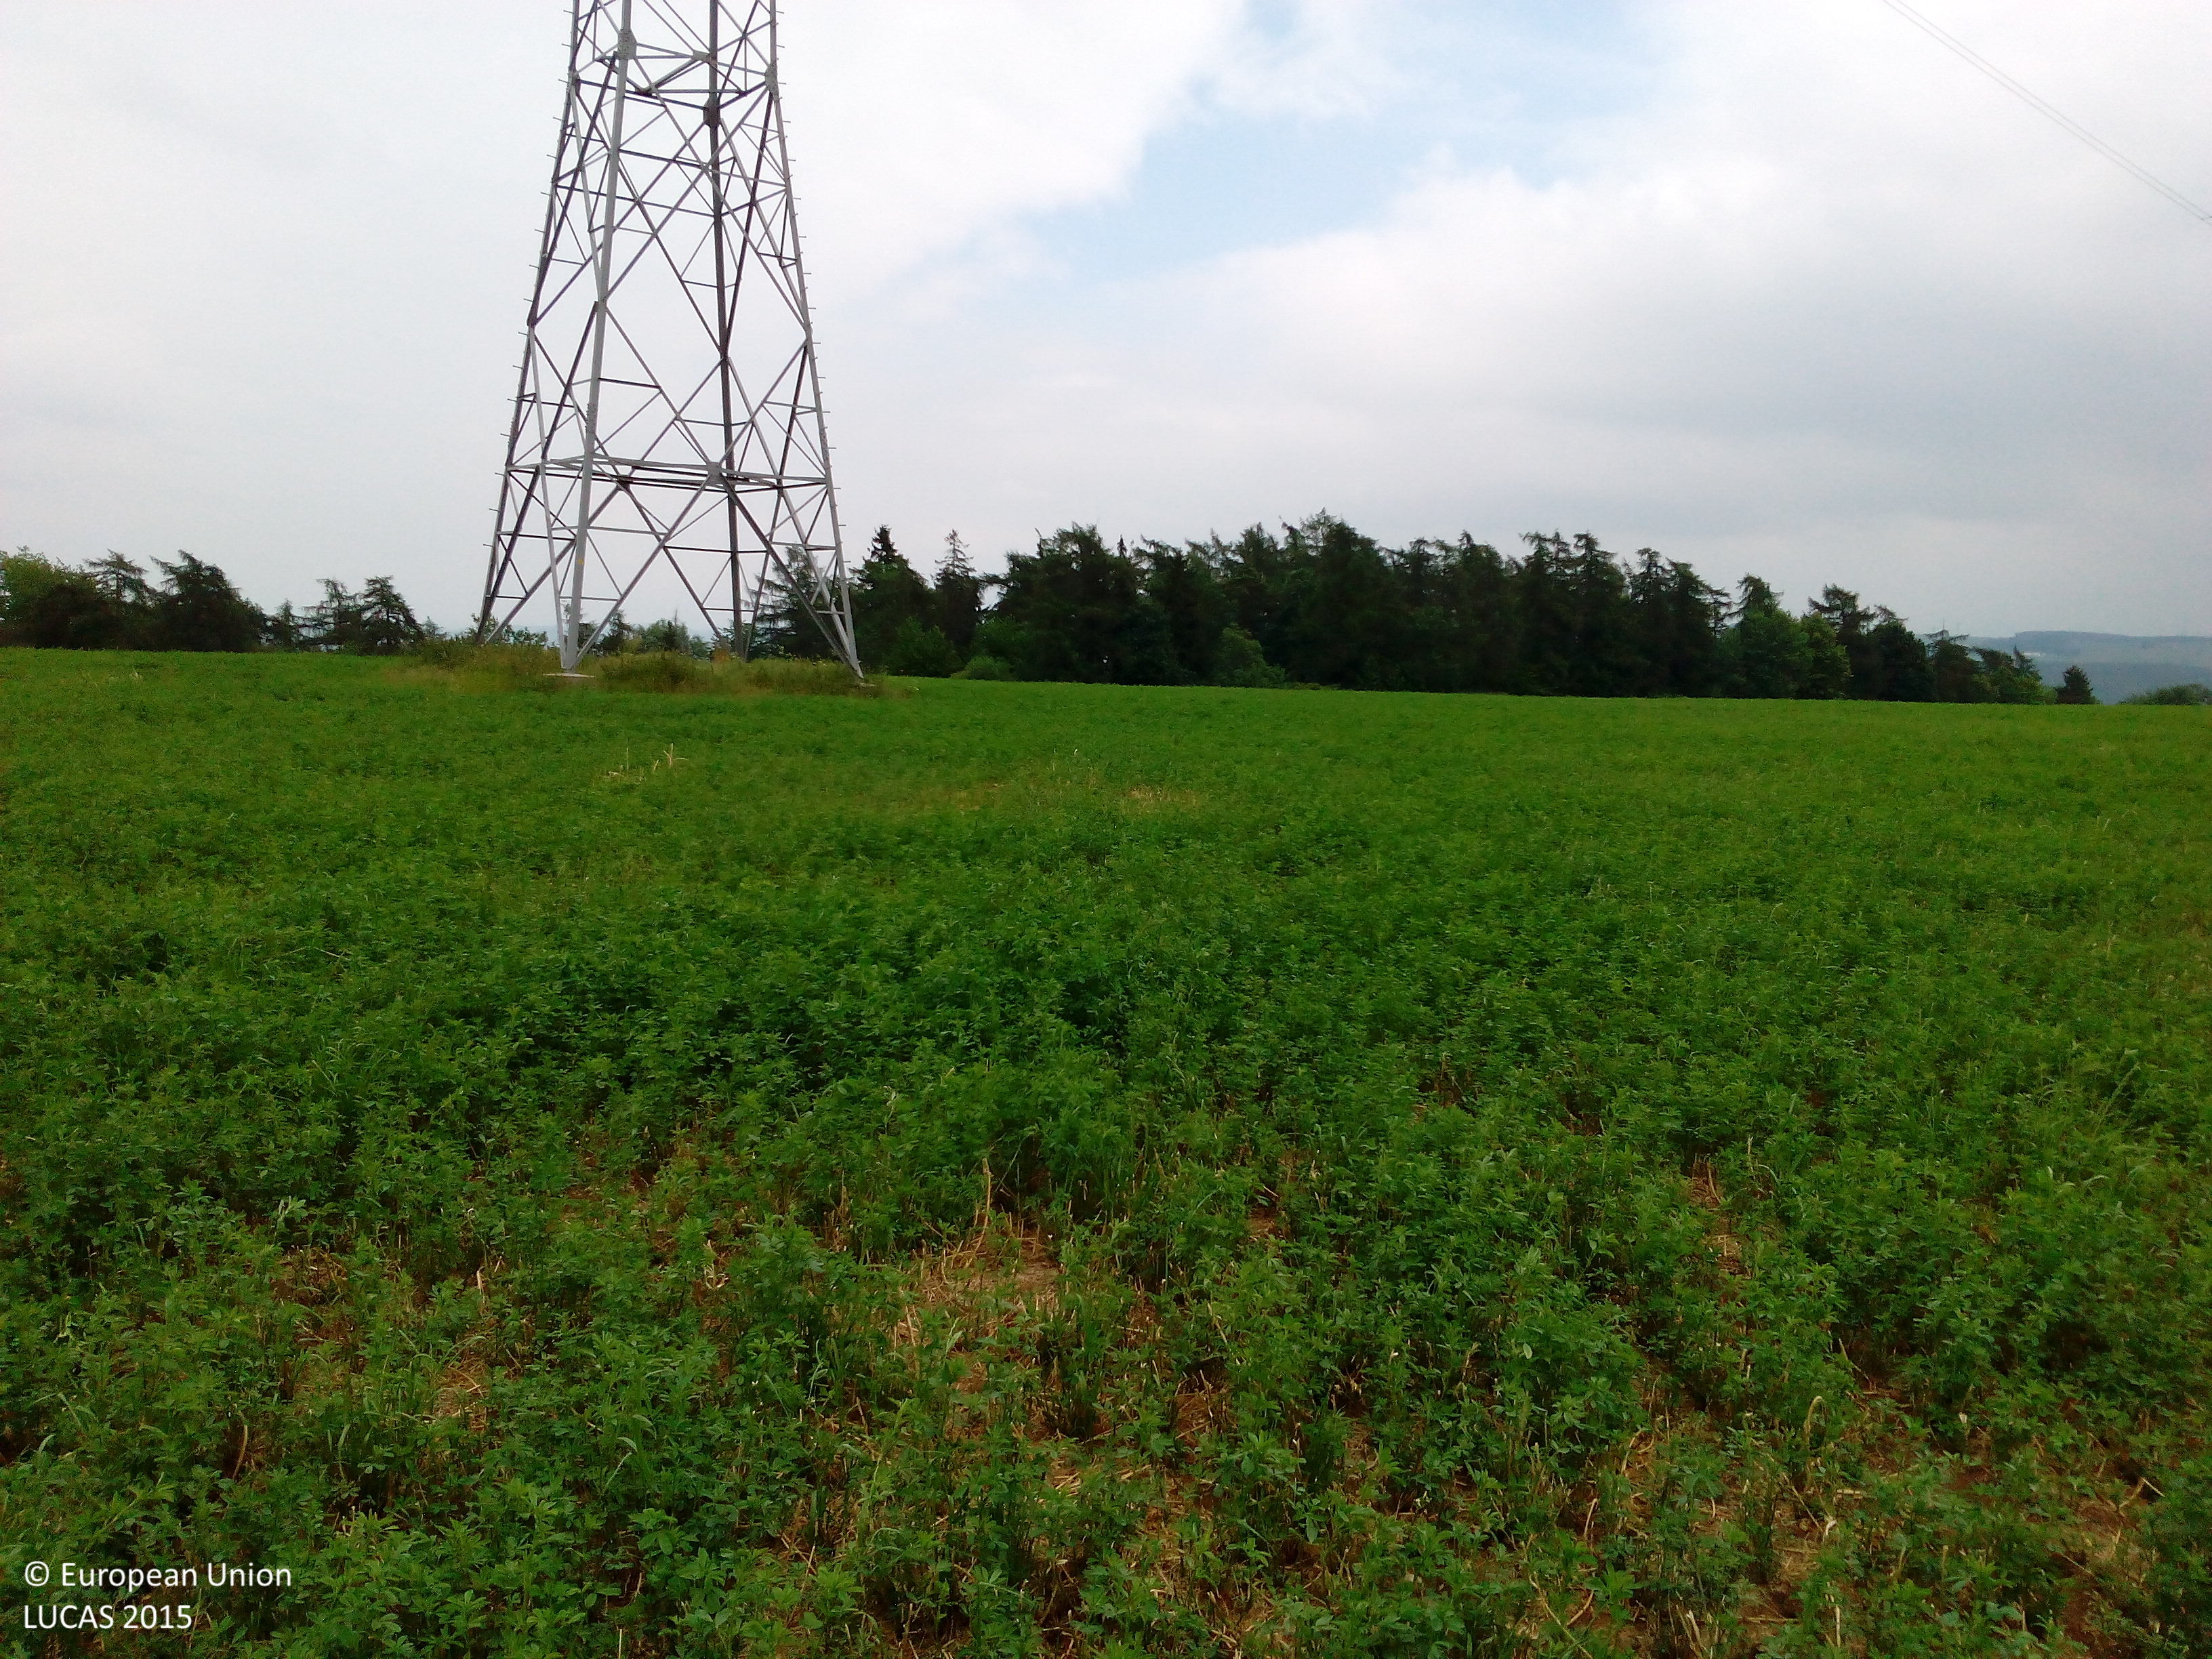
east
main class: Cropland
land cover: Lucerne
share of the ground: > 75 %
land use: Agriculture (excluding fallow land and kitchen gardens)
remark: Burnt area
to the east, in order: Lucerne; Electric lines; Lucerne; Shrubland with sparse tree cover; Pine dominated mixed woodland
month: June
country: DE
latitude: 50.6429
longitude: 11.4279
